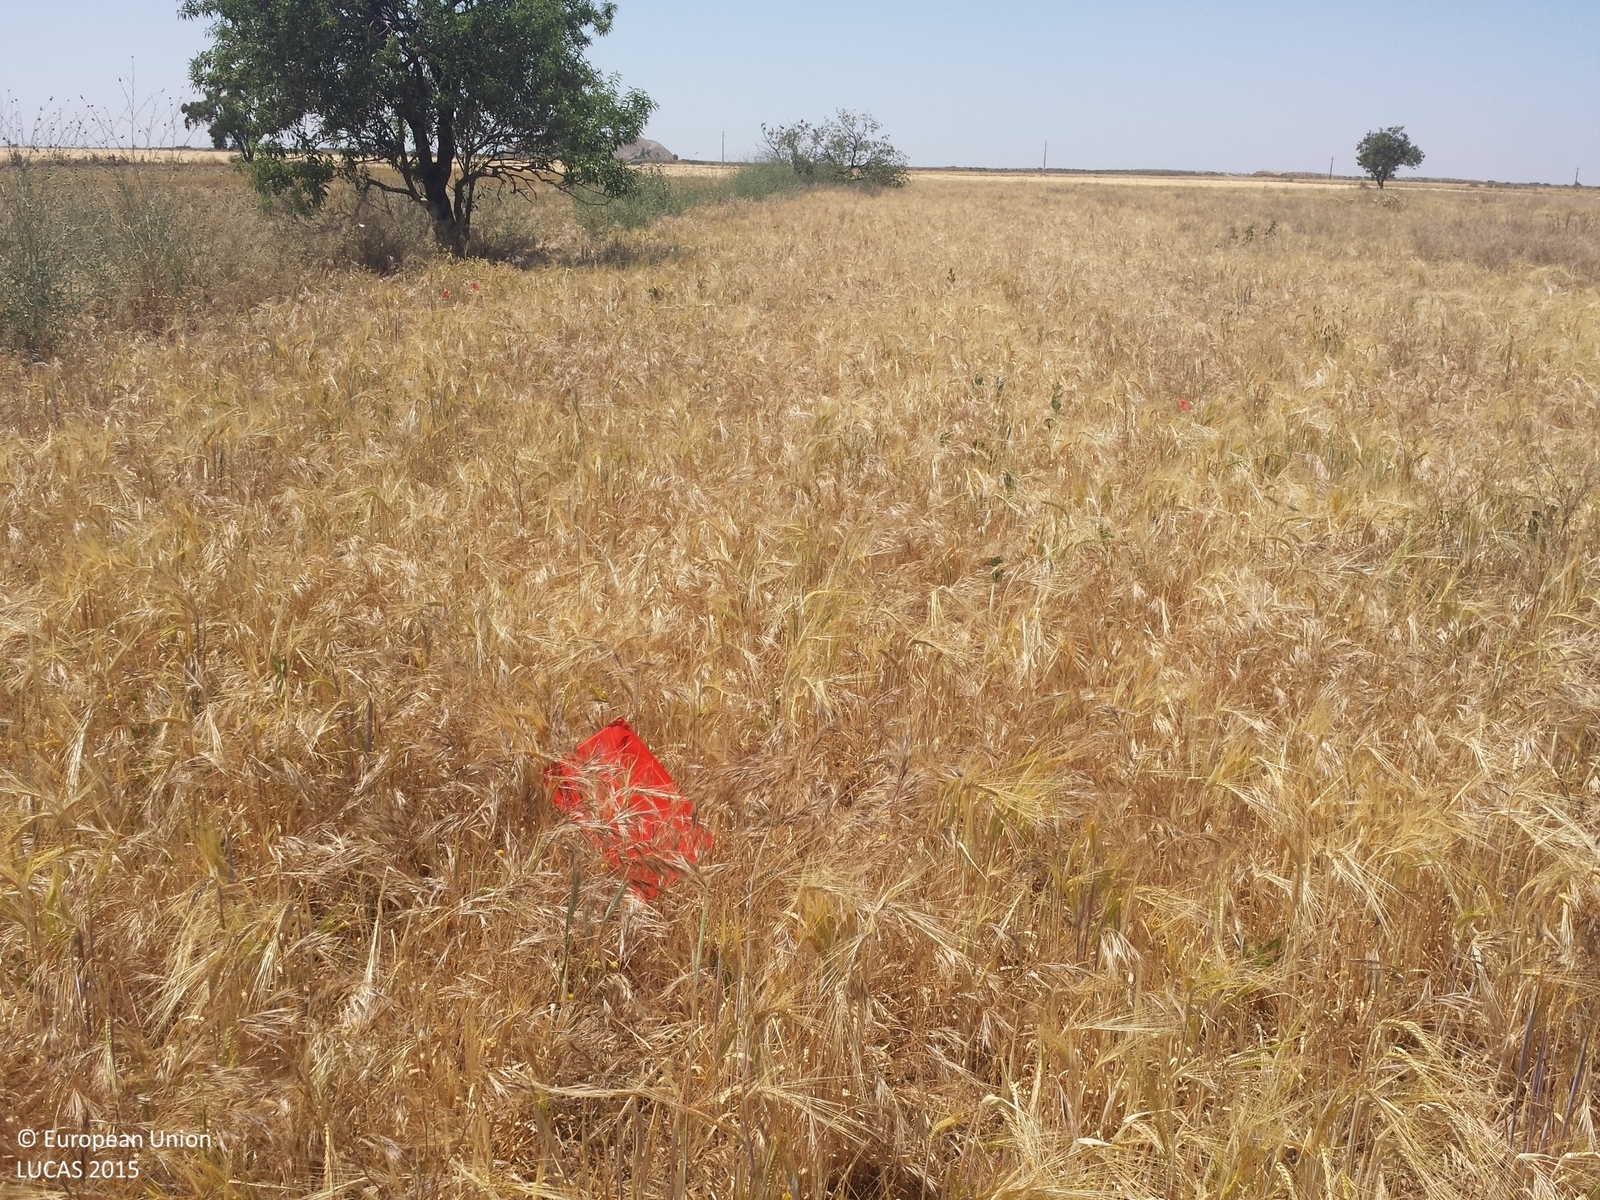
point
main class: Cropland
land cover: Barley
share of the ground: > 75 %
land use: Agriculture (excluding fallow land and kitchen gardens)
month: May
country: ES
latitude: 41.7766
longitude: 0.5660
